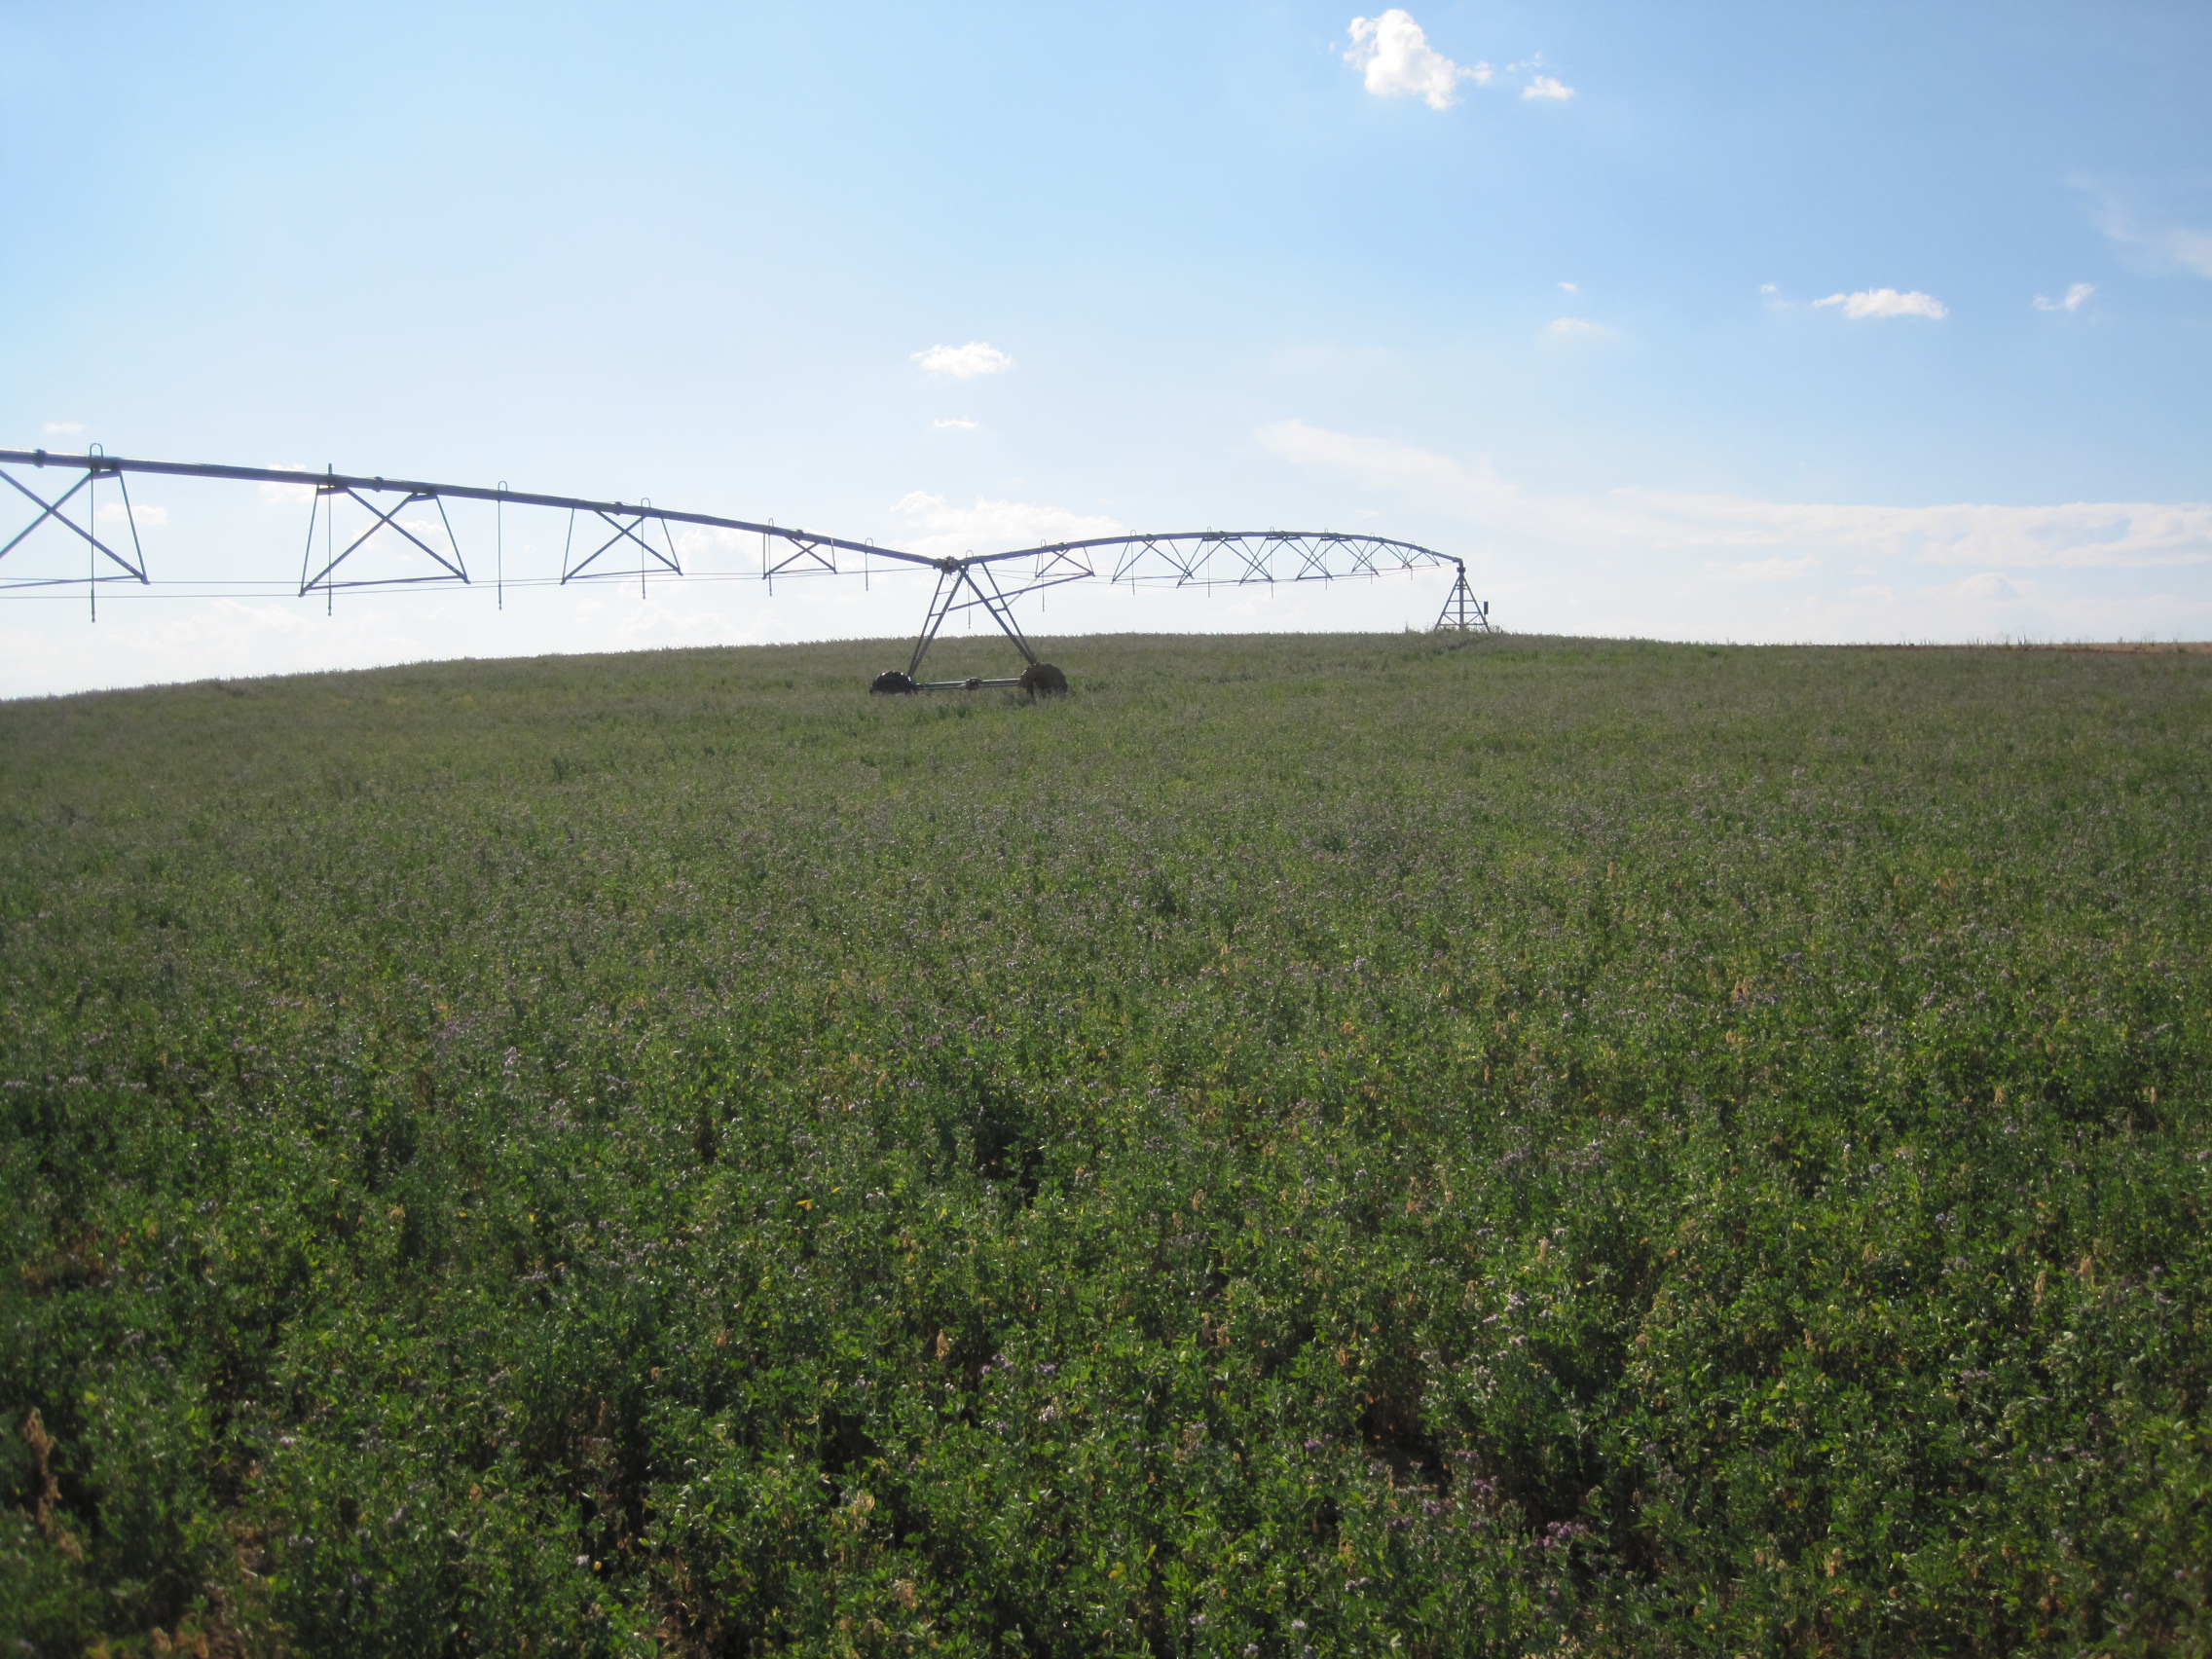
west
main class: Cropland
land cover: Lucerne
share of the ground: > 75 %
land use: Agriculture (excluding fallow land and kitchen gardens)
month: July
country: ES
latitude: 41.9049
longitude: -5.1855
